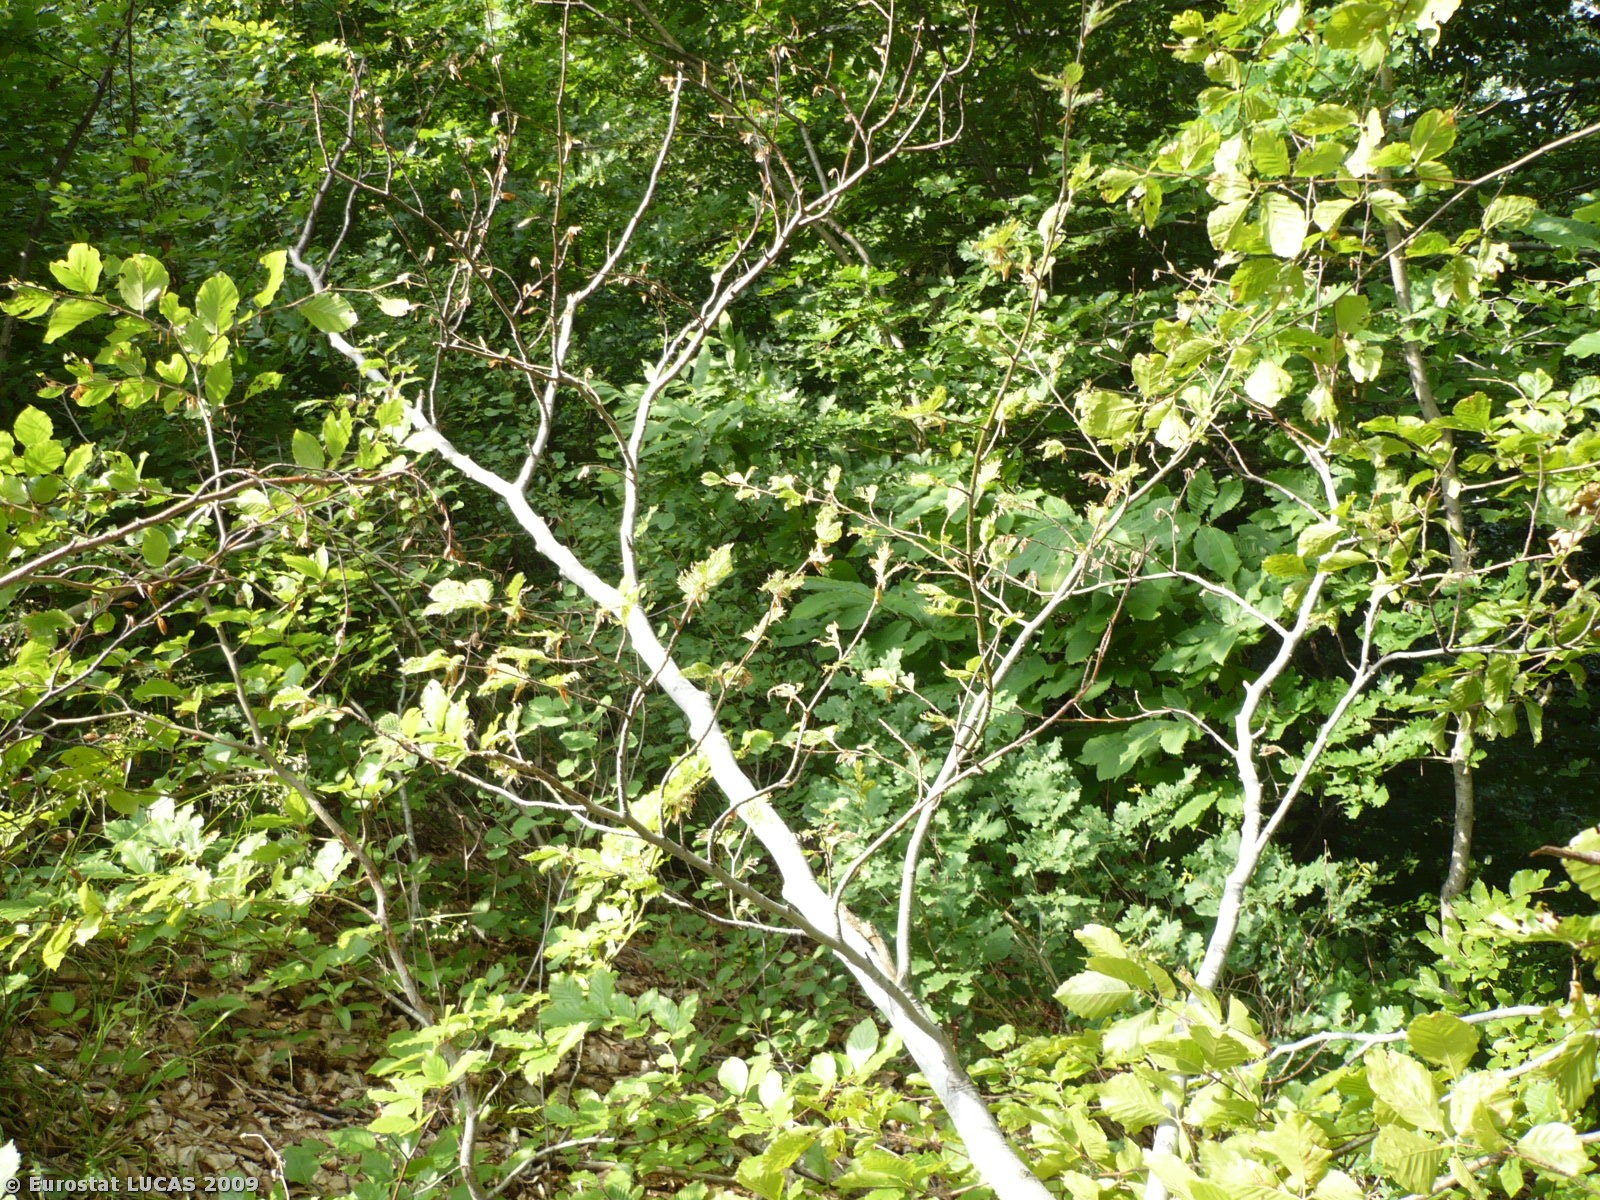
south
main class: Woodland
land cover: Broadleaved woodland
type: beech forest
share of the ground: > 75 %
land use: Forestry
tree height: > 5 m
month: June
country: SI
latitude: 46.1441
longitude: 15.3703
